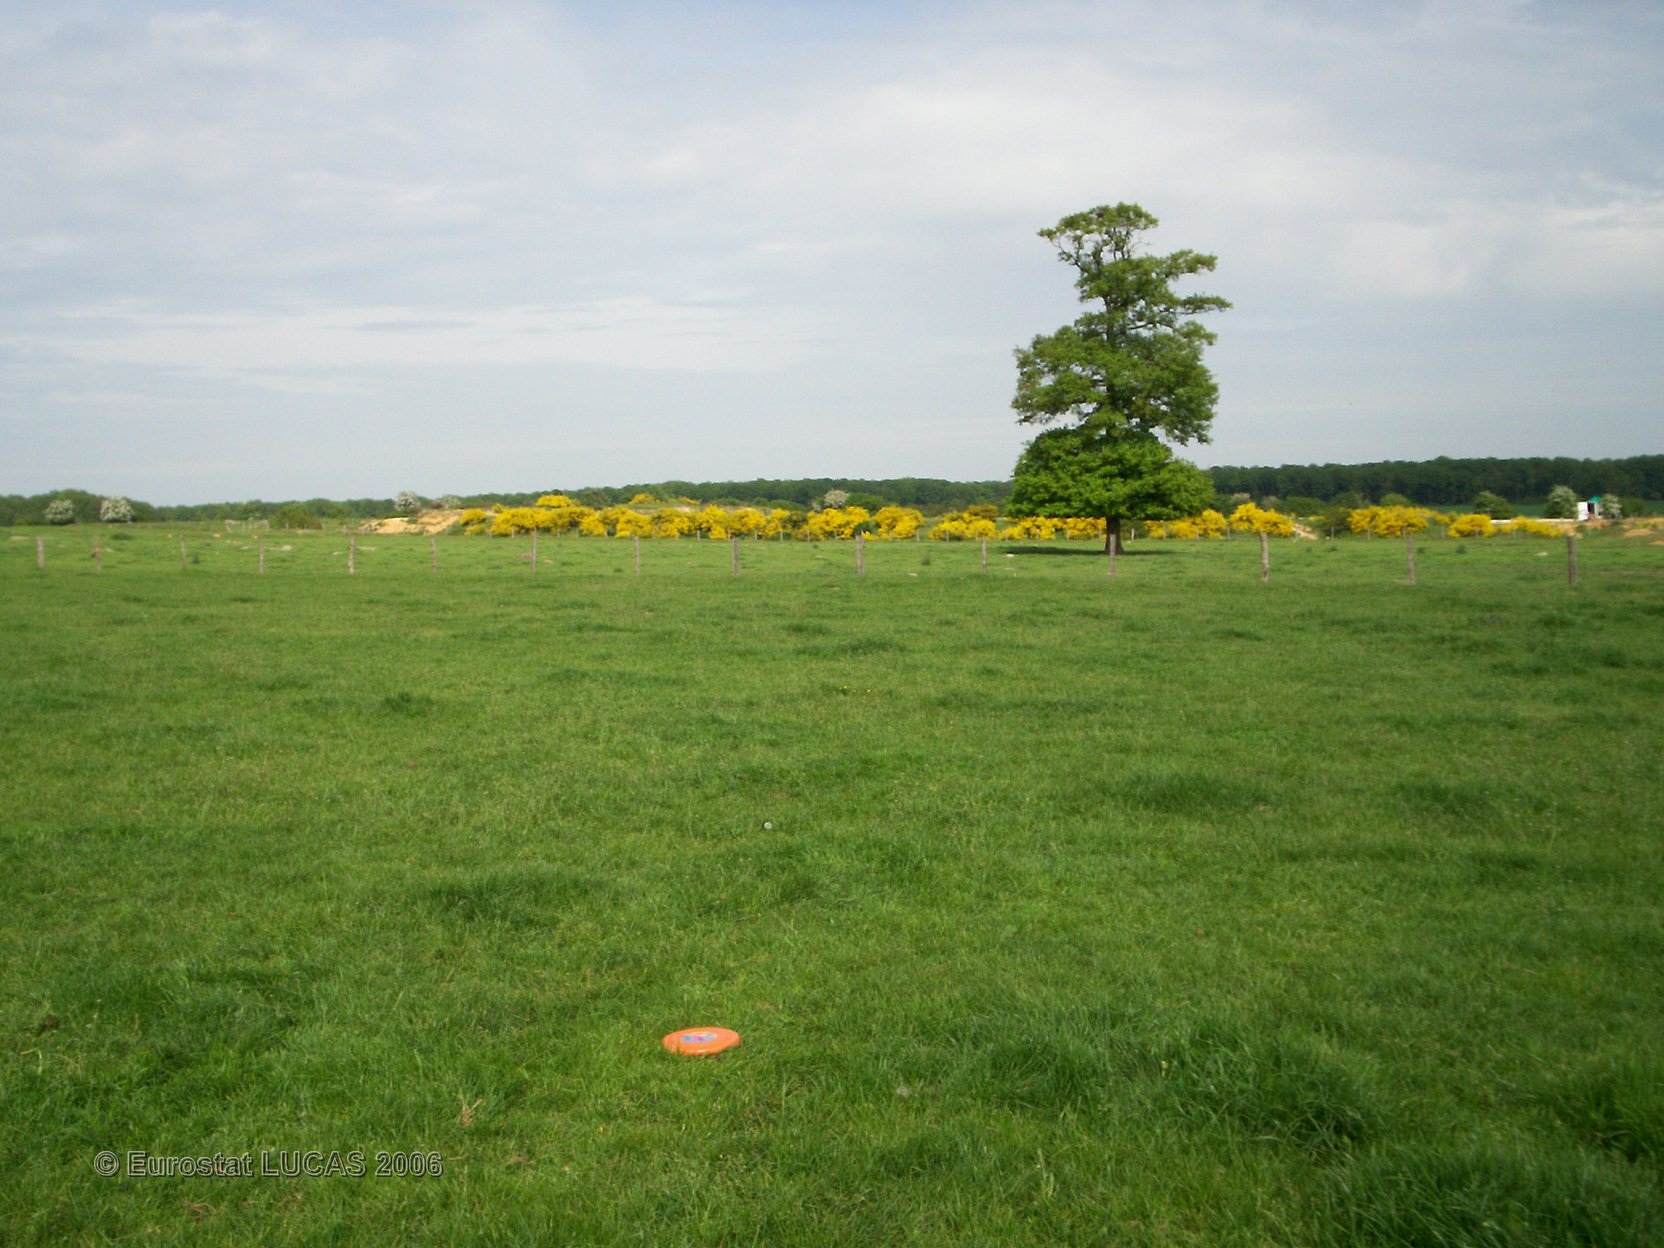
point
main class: Grassland
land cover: Grassland without tree/shrub cover
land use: Agriculture (excluding fallow land and kitchen gardens)
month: May
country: FR
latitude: 48.6622
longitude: 2.8902
